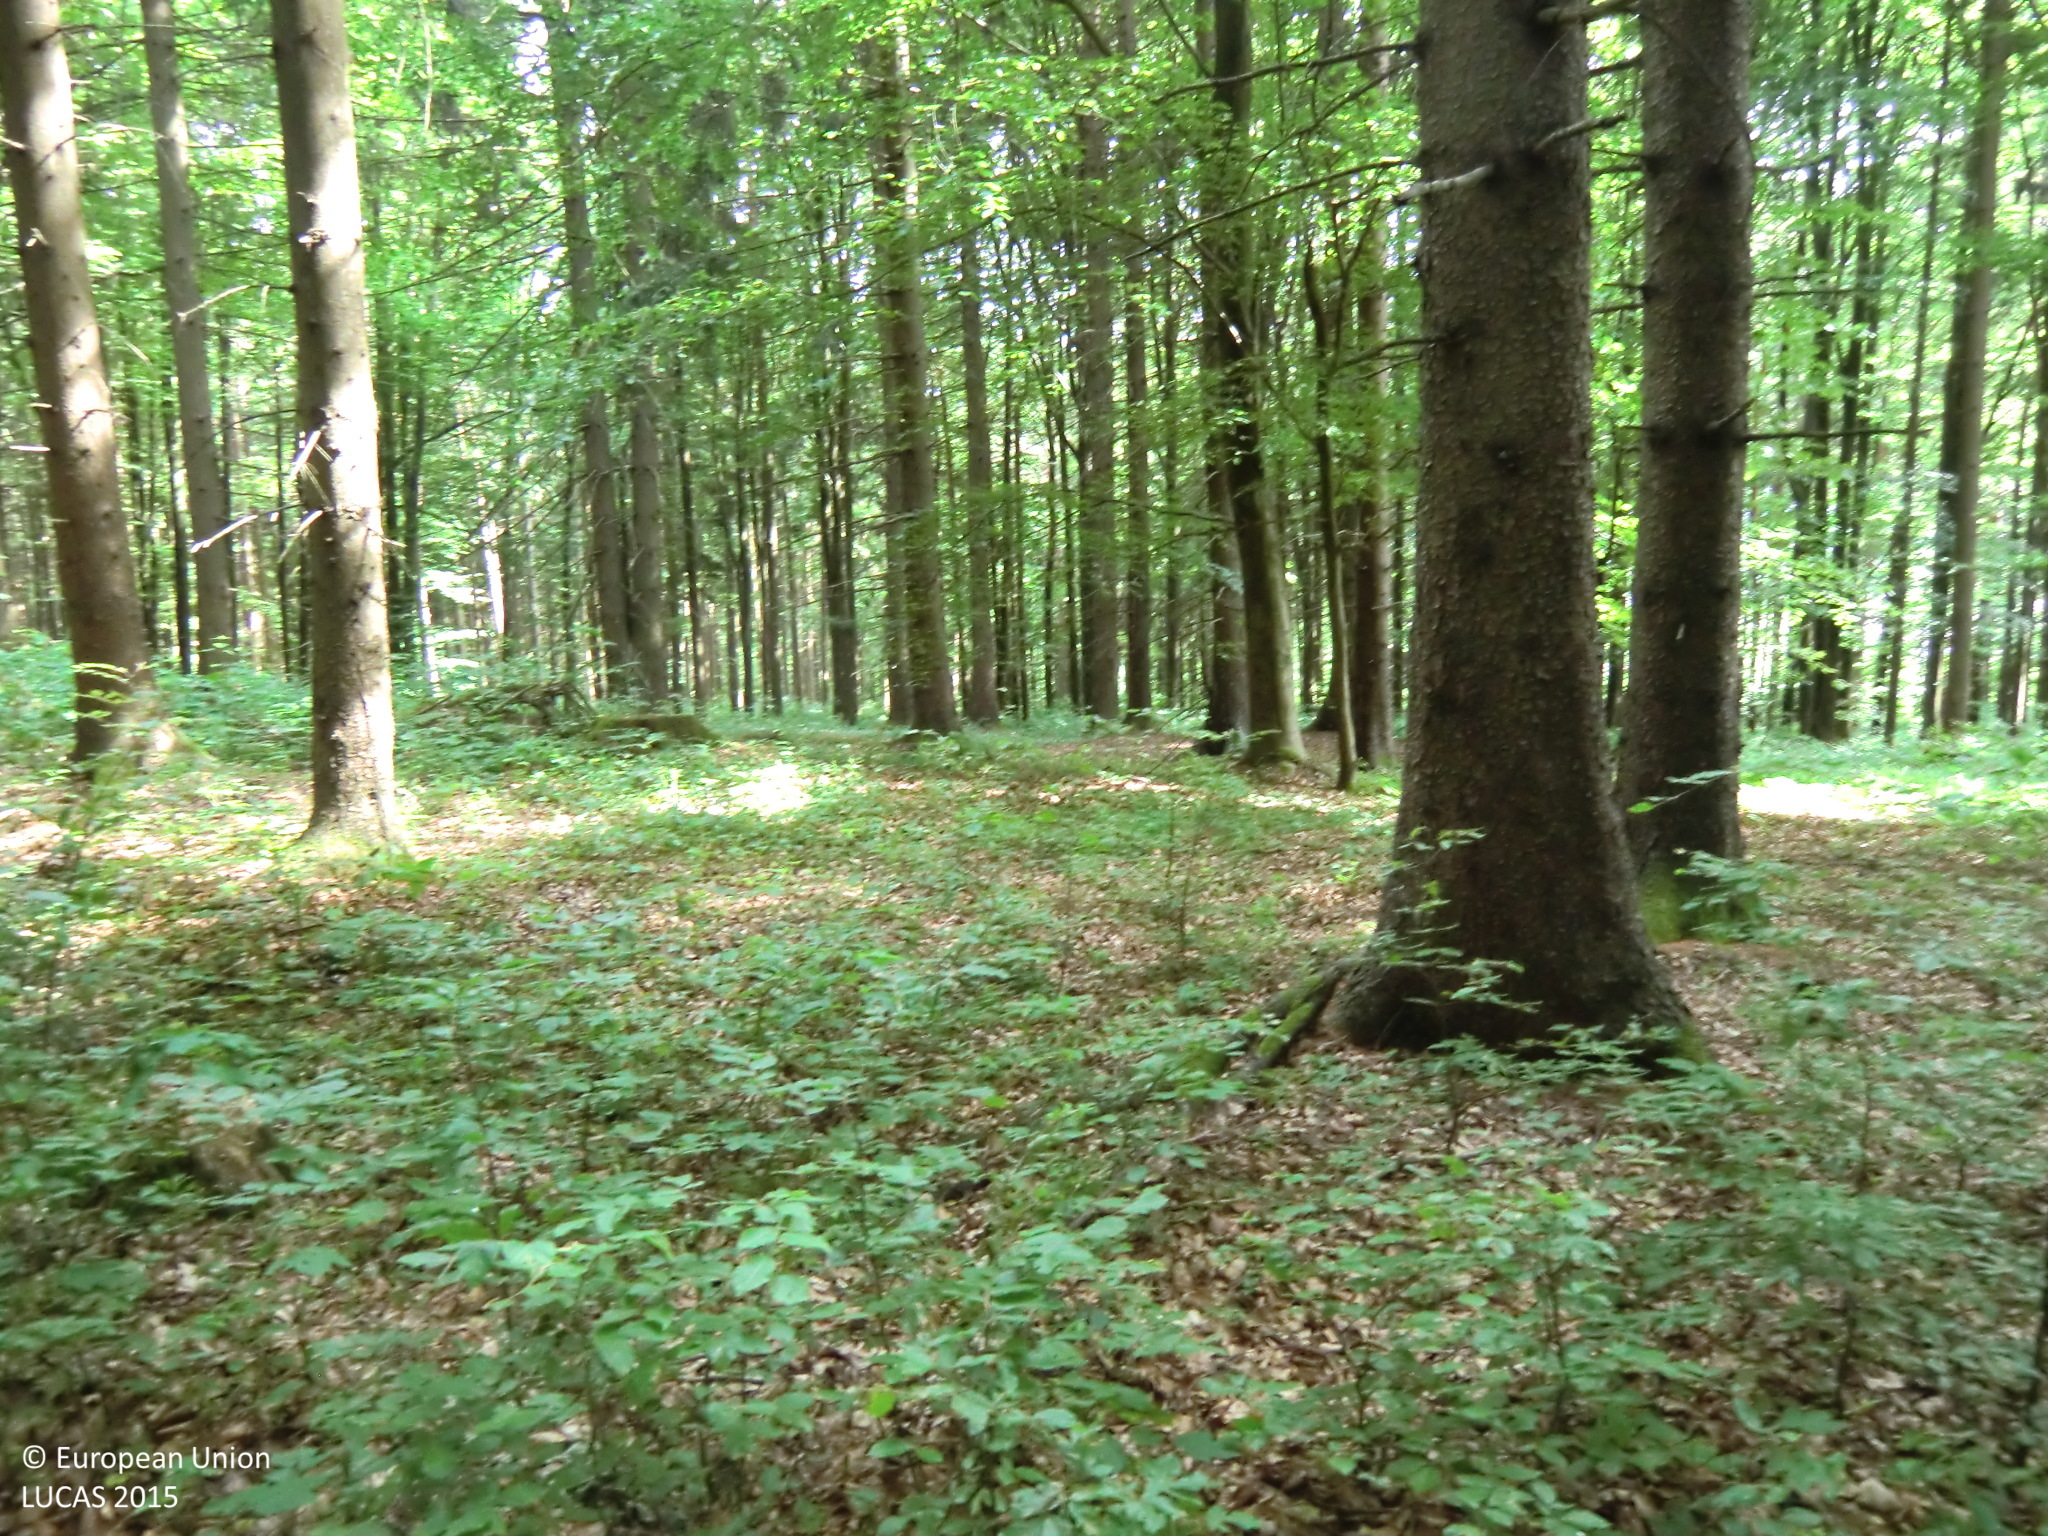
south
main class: Woodland
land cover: Spruce dominated mixed woodland
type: hemiboreal forest and nemoral coniferous forest and mixed broadleaved-coniferous forest
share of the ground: > 75 %
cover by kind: coniferous forest trees 45 %, broadleaved forest trees 45 %, shrubs 5 %, herbaceous plants 5 %
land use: Forestry
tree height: > 5 m
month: May
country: AT
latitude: 48.2161
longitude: 15.0483
